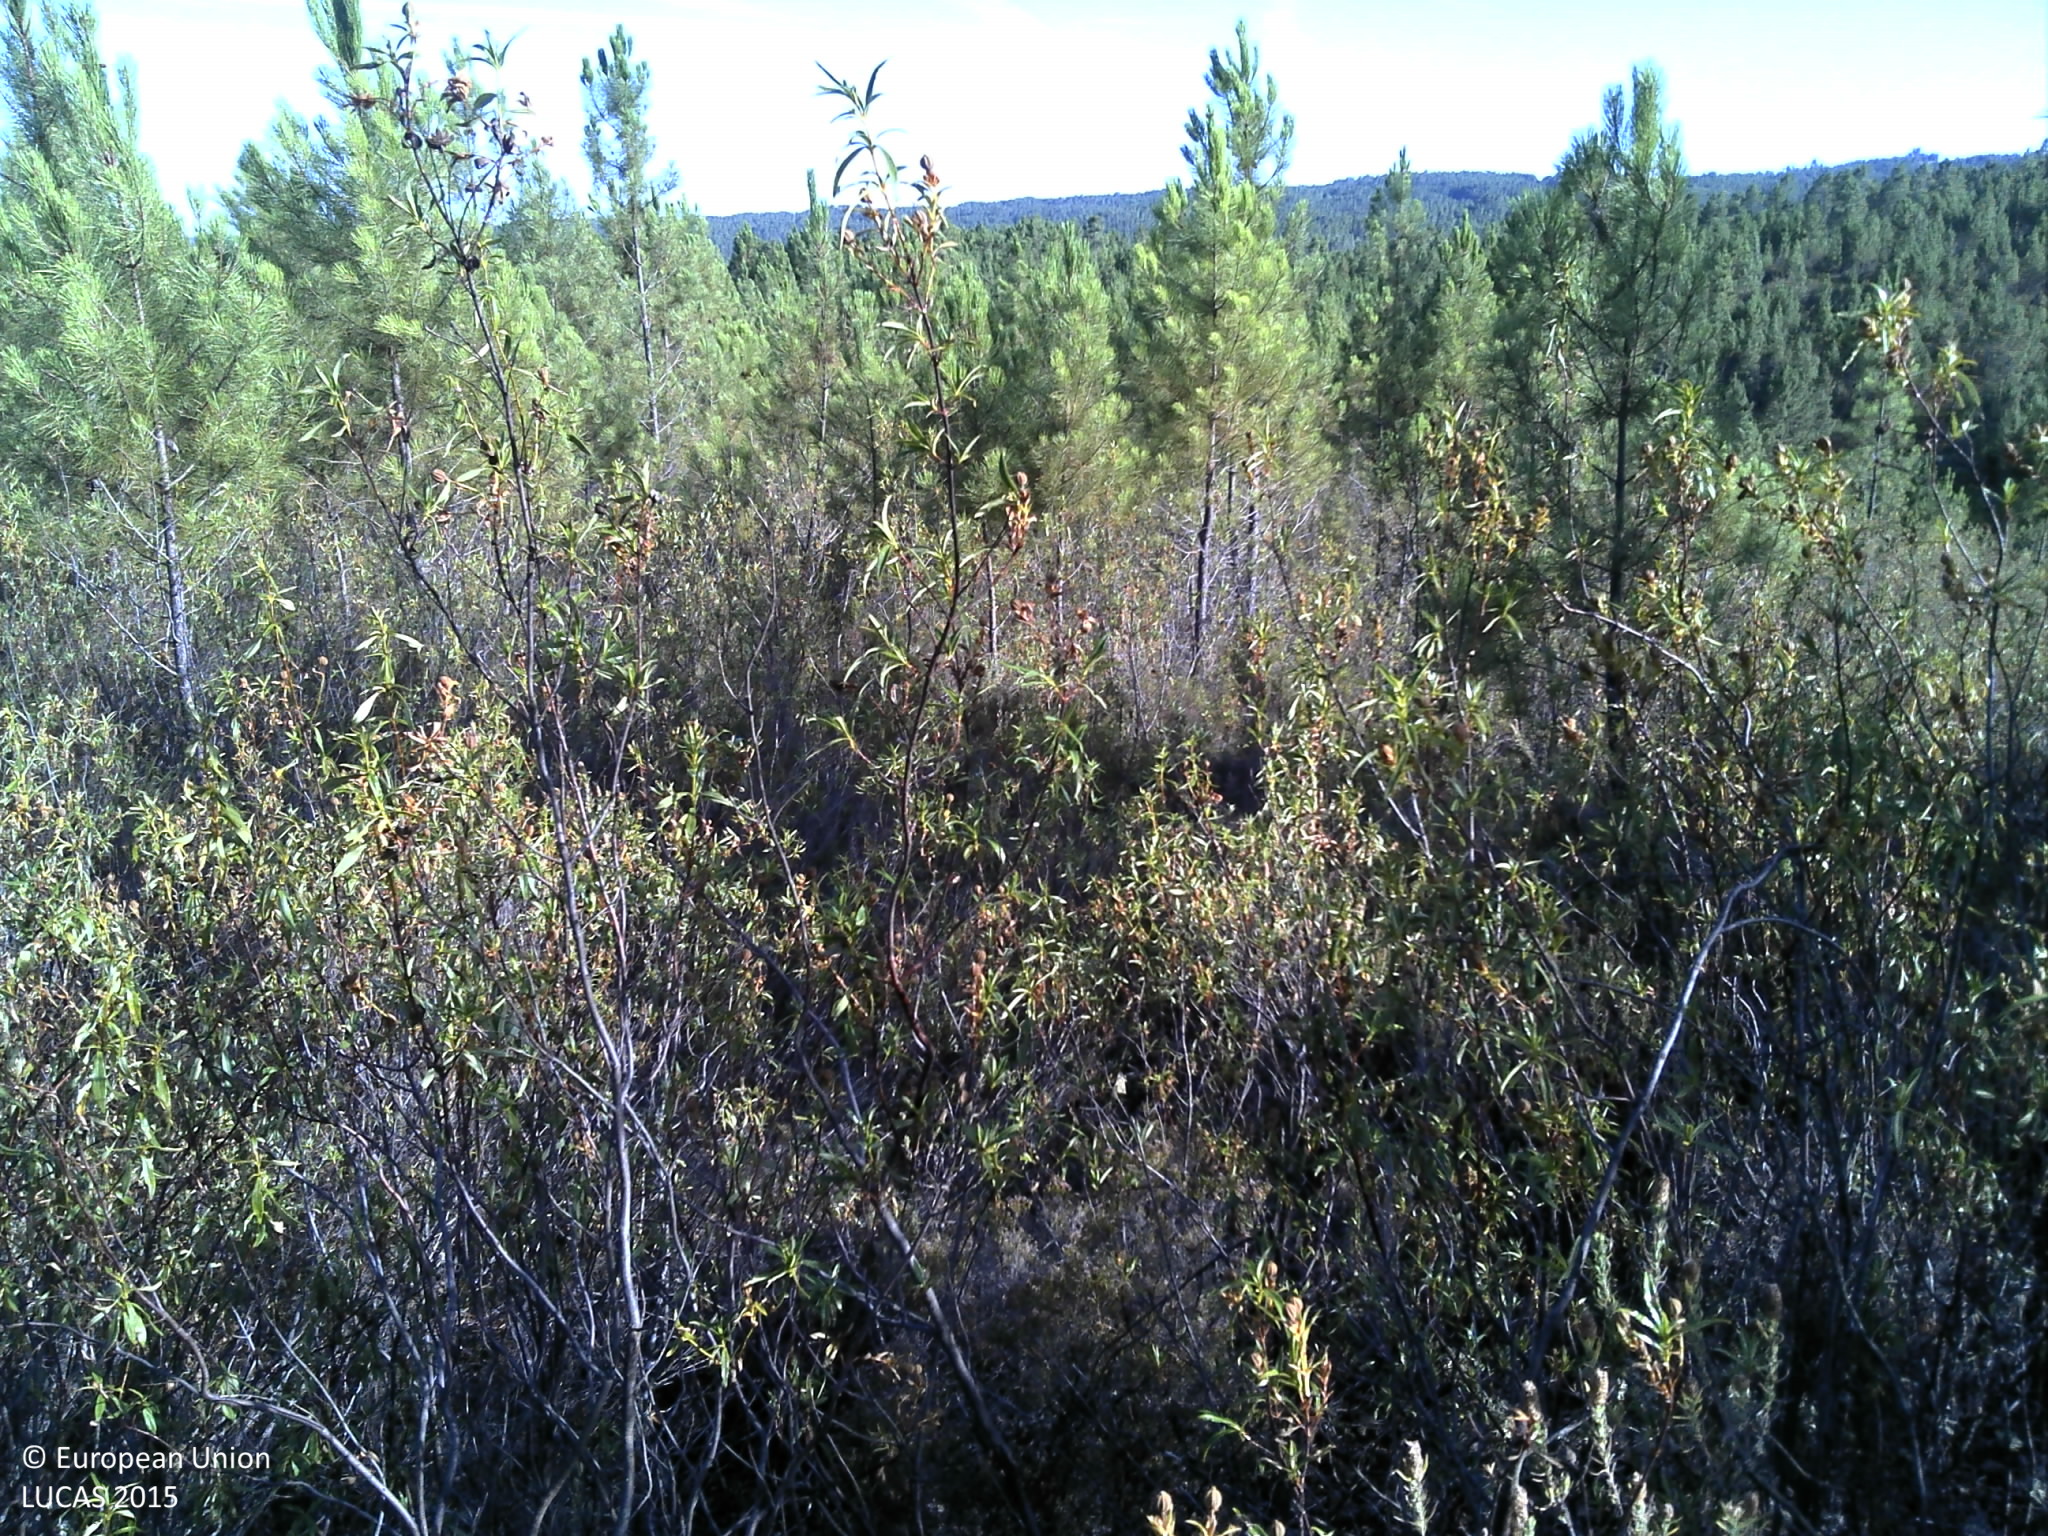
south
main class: Woodland
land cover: Pine dominated coniferous woodland
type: coniferous forest of the mediterranean region
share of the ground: < 10 %
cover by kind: shrubs 90 %, coniferous forest trees 10 %
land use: Forestry
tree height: < 5 m
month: July
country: PT
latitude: 39.7322
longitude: -7.8052
